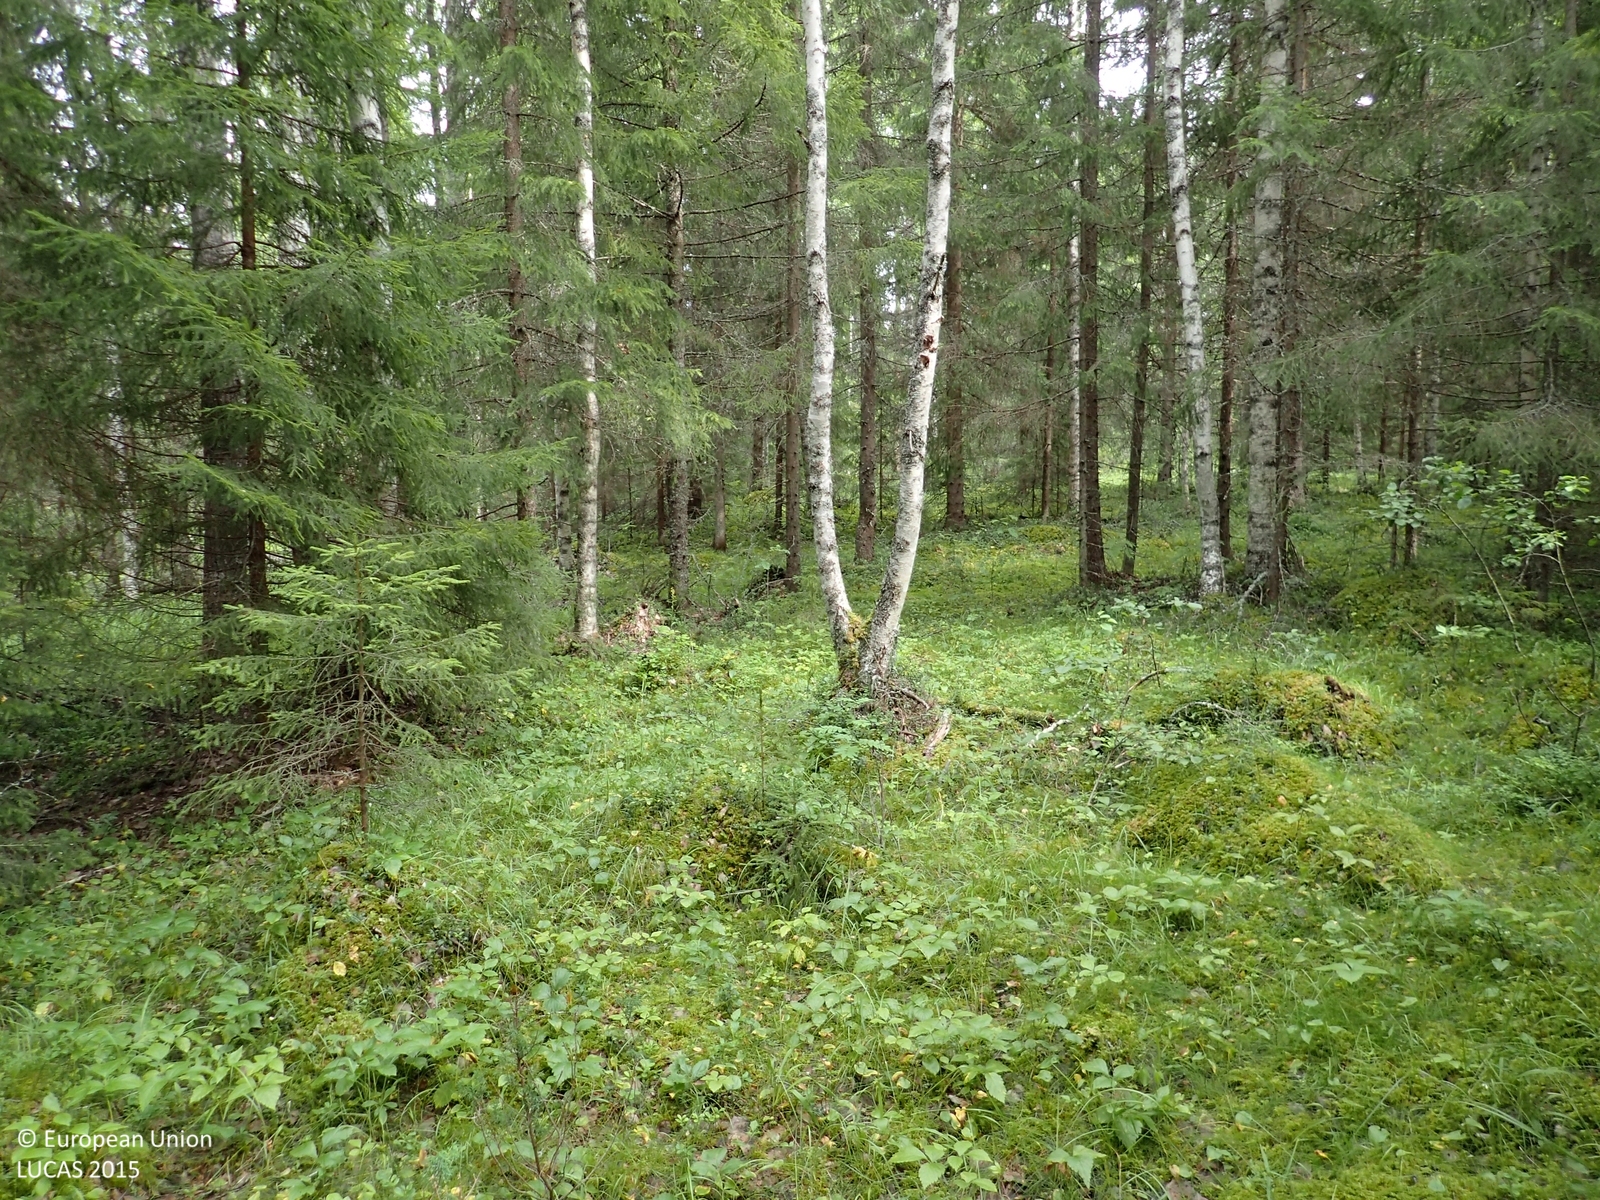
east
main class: Woodland
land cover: Spruce dominated mixed woodland
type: boreal forest
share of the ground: > 75 %
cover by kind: coniferous forest trees 60 %, broadleaved forest trees 20 %, herbaceous plants 10 %, shrubs 5 %, lichens and mosses 5 %
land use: Forestry
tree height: > 5 m
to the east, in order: Spruce dominated mixed woodland; Ditches and canals; Spruce dominated mixed woodland; Ditches and canals; Spruce dominated mixed woodland; Ditches and canals; Spruce dominated mixed woodland; Ditches and canals; Other coniferous woodland
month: August
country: FI
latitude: 62.8314
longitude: 21.9221
